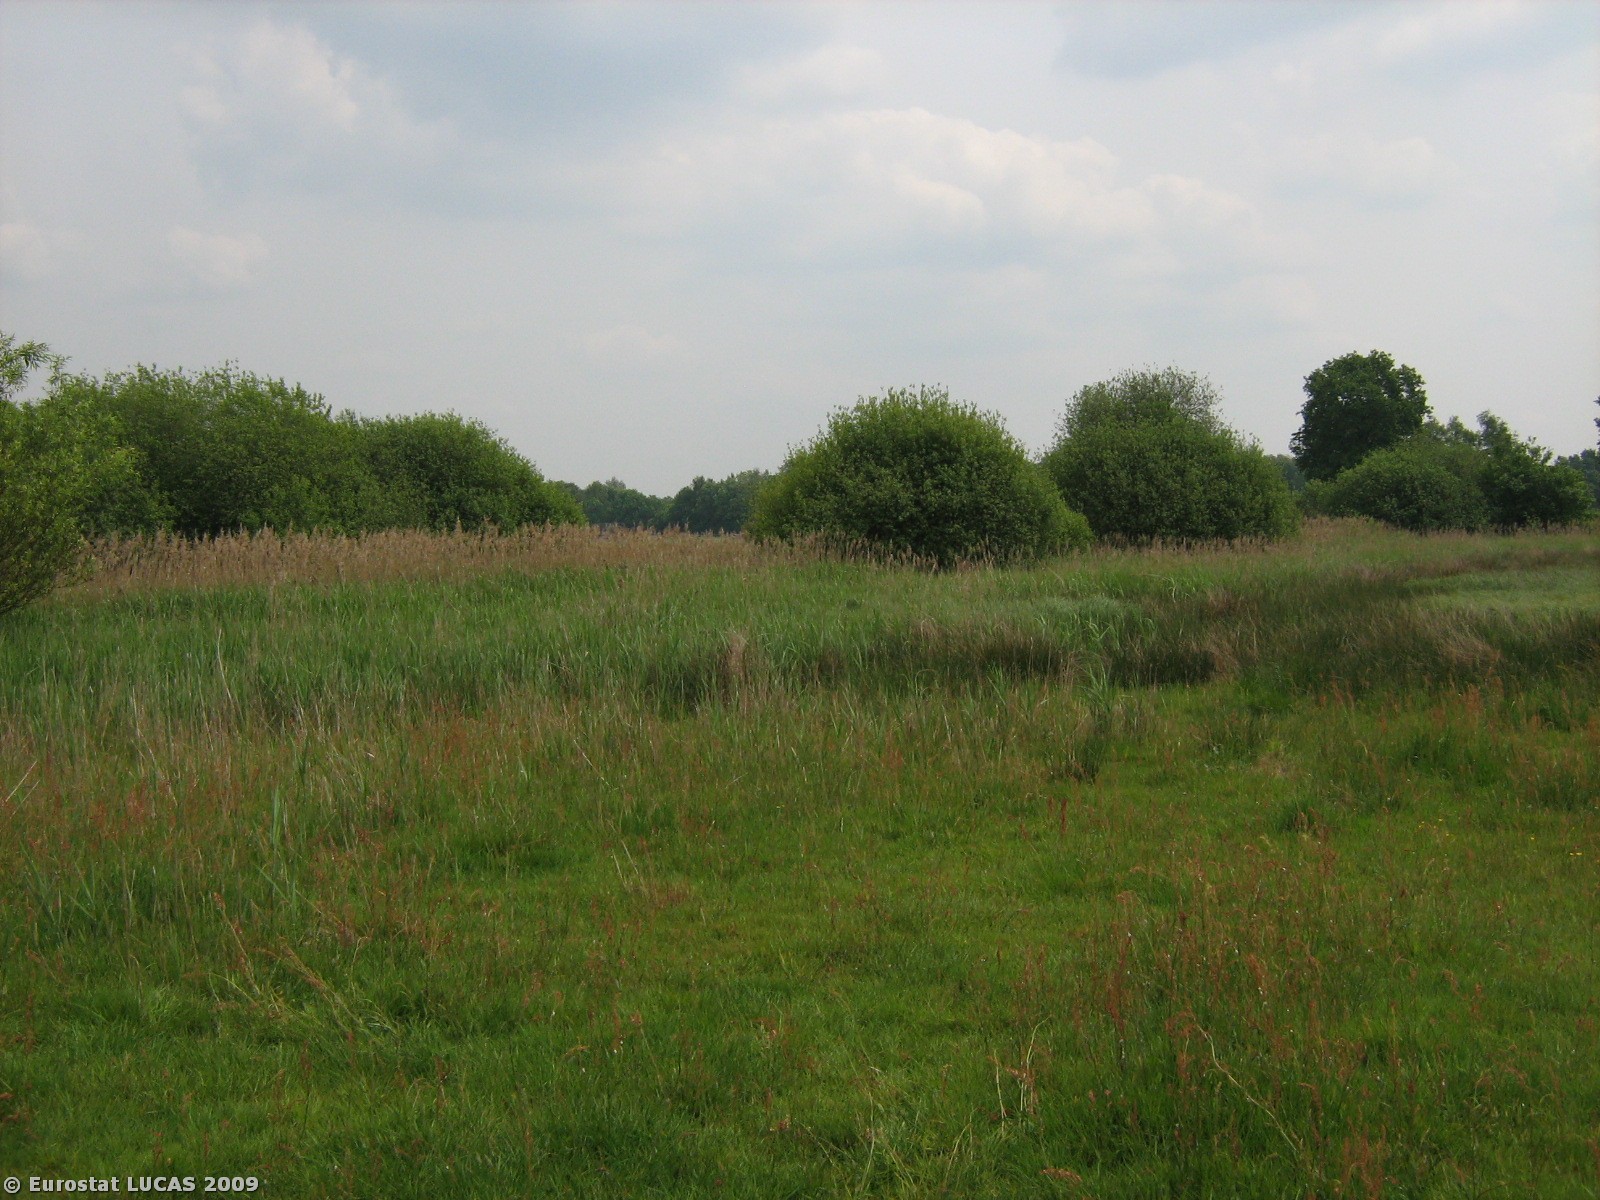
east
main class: Grassland
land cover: Grassland without tree/shrub cover
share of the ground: > 75 %
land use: Nature reserves
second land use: Agriculture (excluding fallow land and kitchen gardens)
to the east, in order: Grassland without tree/shrub cover; Single bushes/trees; Grassland without tree/shrub cover; Fences; Grass margins; Tracks; Grass margins; Ditches and canals; Grass margins; Potatoes; Floriculture and ornamental plants; Nurseries
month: May
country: NL
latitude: 51.3001
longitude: 5.4514
